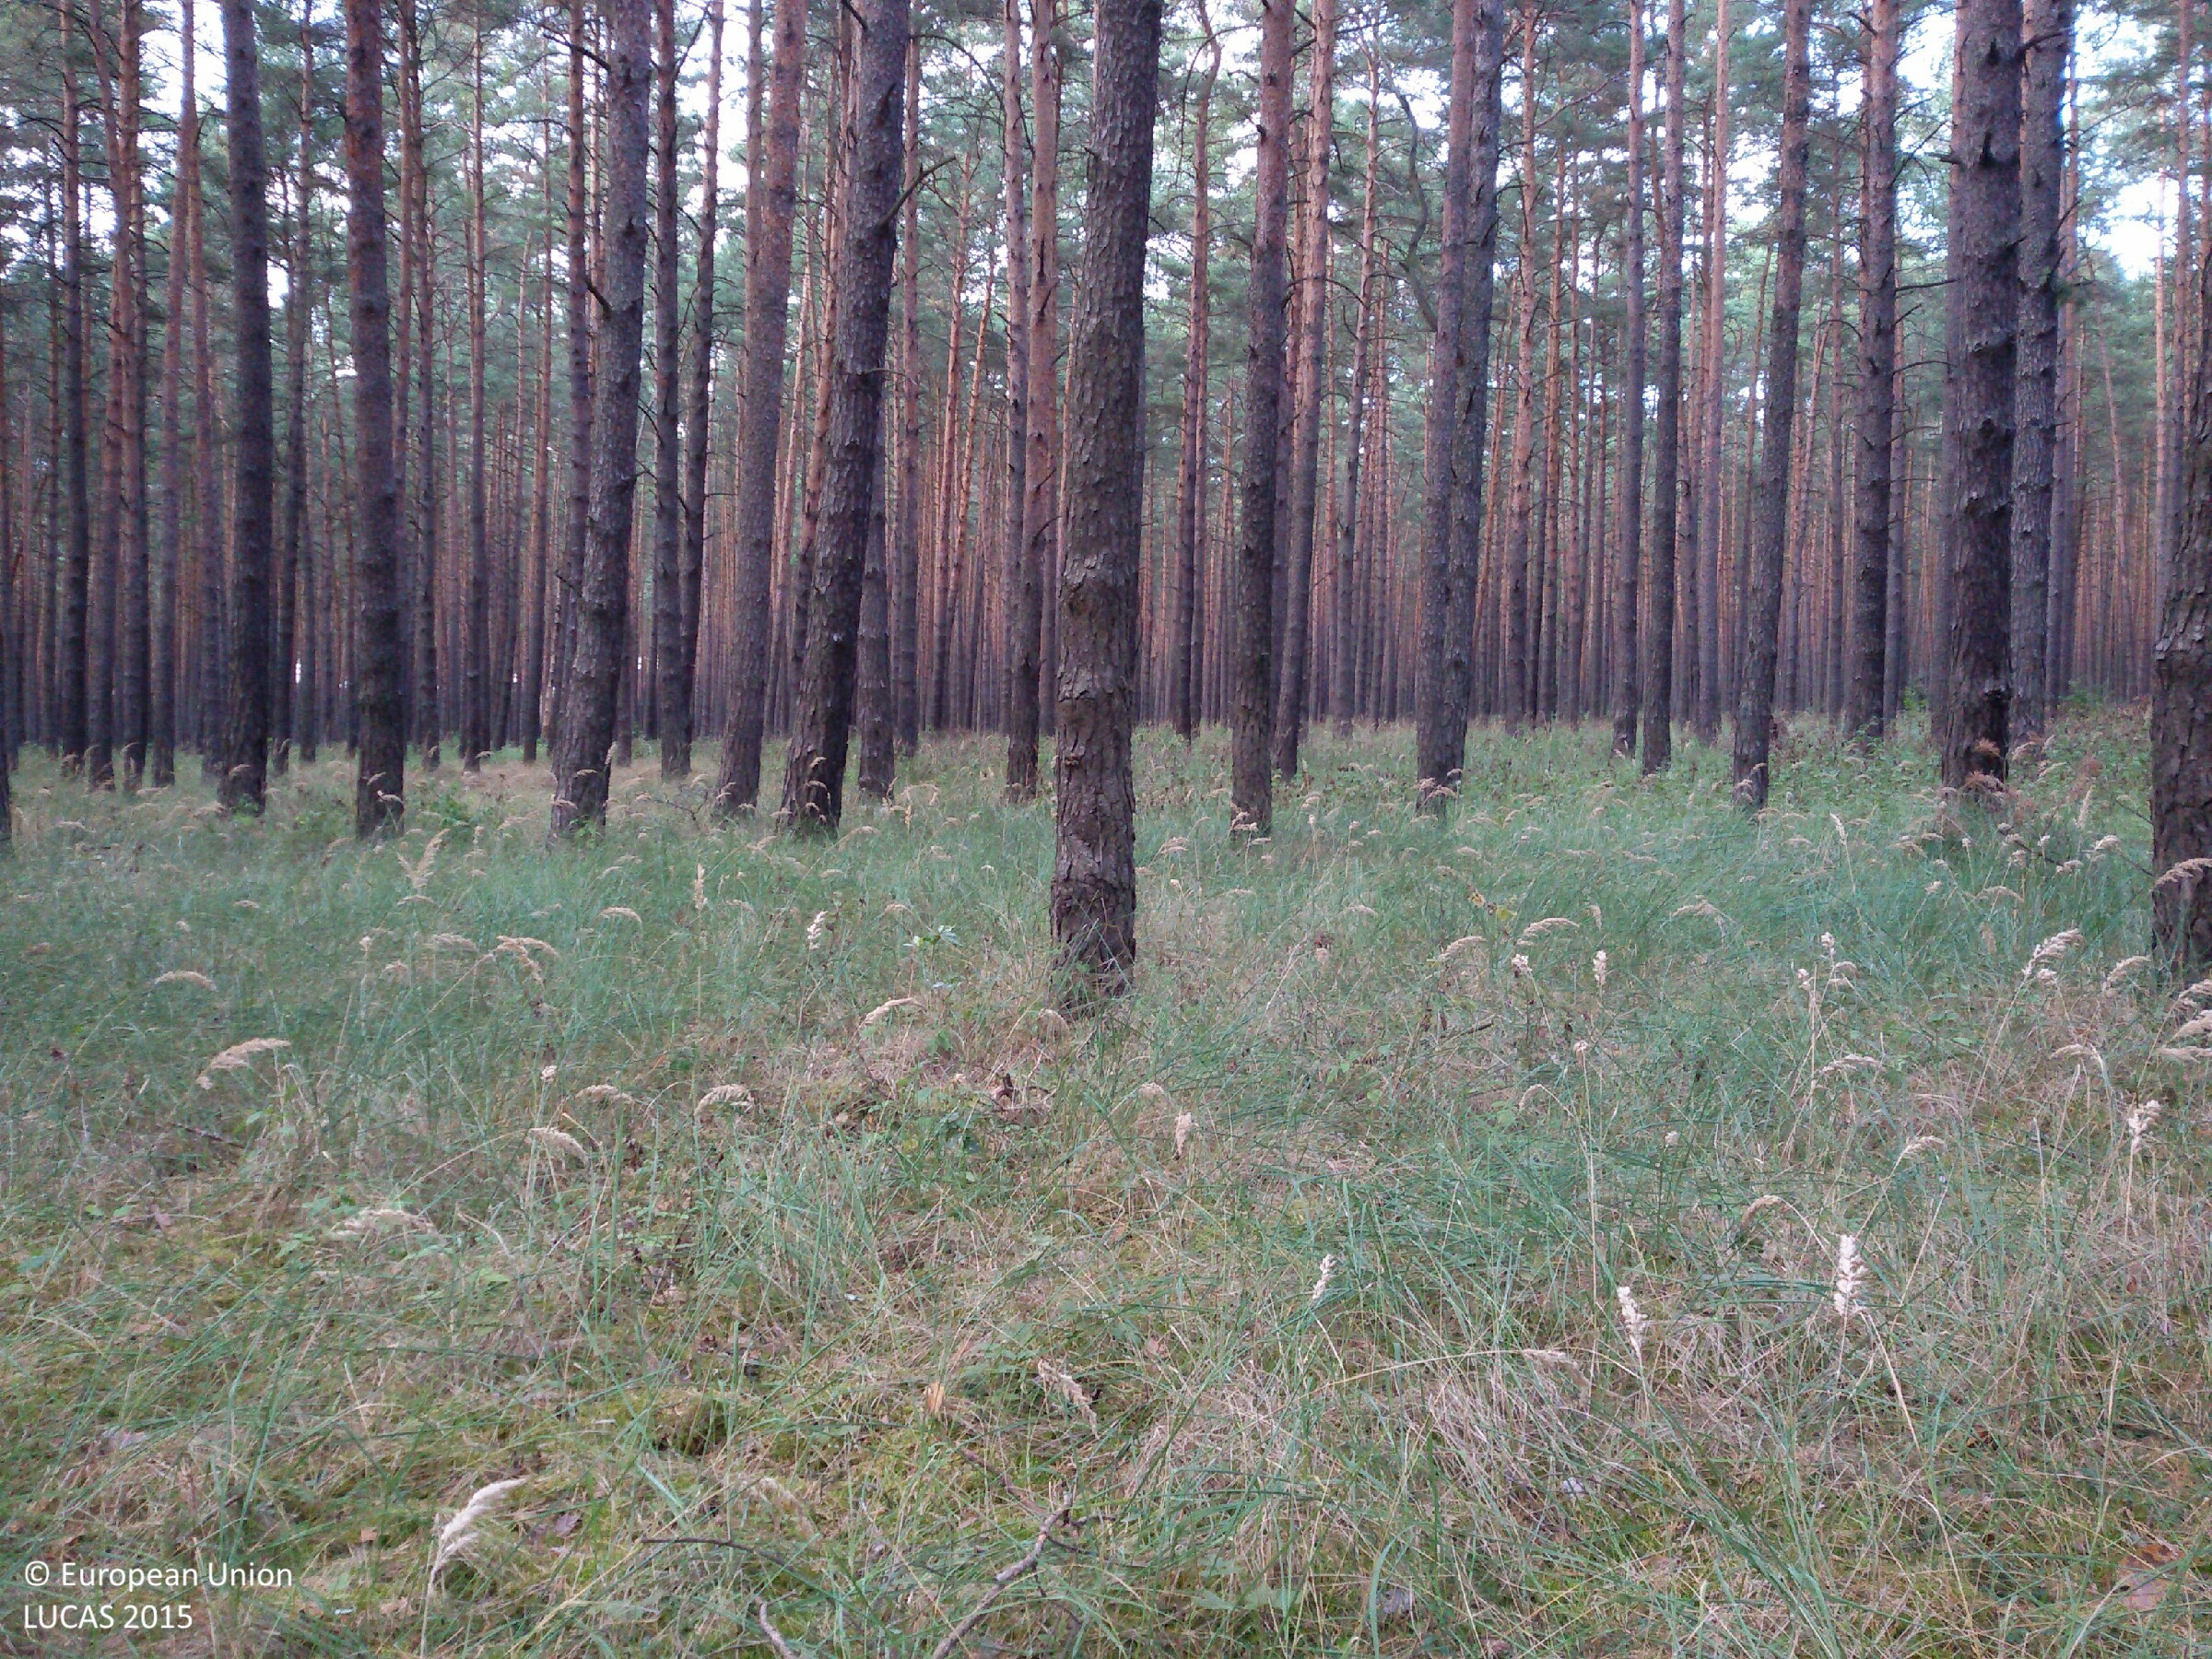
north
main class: Woodland
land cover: Pine dominated coniferous woodland
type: hemiboreal forest and nemoral coniferous forest and mixed broadleaved-coniferous forest
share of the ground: > 75 %
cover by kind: coniferous forest trees 85 %, herbaceous plants 15 %
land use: Forestry
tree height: > 5 m
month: September
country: PL
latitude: 52.2651
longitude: 14.7349
